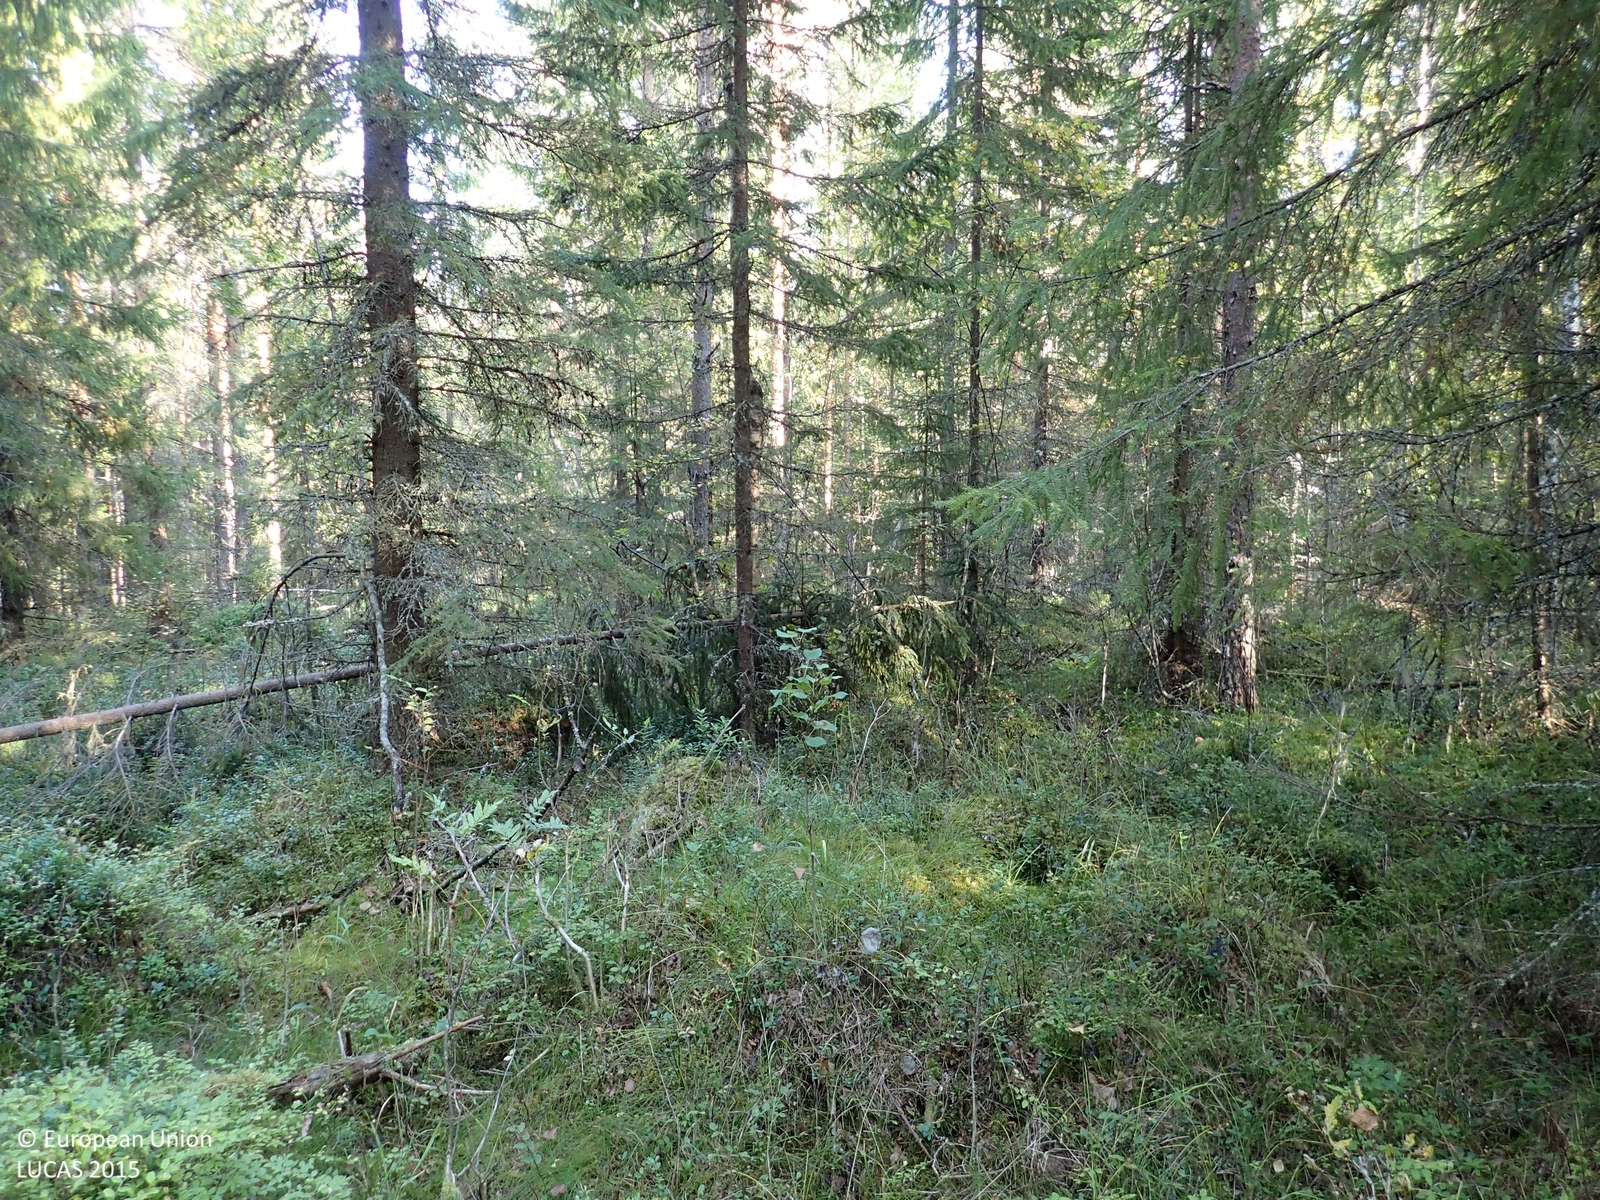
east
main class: Woodland
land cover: Spruce dominated coniferous woodland
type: boreal forest
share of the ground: > 75 %
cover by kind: coniferous forest trees 70 %, shrubs 15 %, broadleaved forest trees 10 %, lichens and mosses 5 %
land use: Forestry
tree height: > 5 m
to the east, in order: Spruce dominated coniferous woodland; Other mixed woodland; Other coniferous woodland
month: September
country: FI
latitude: 62.9075
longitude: 25.5187
